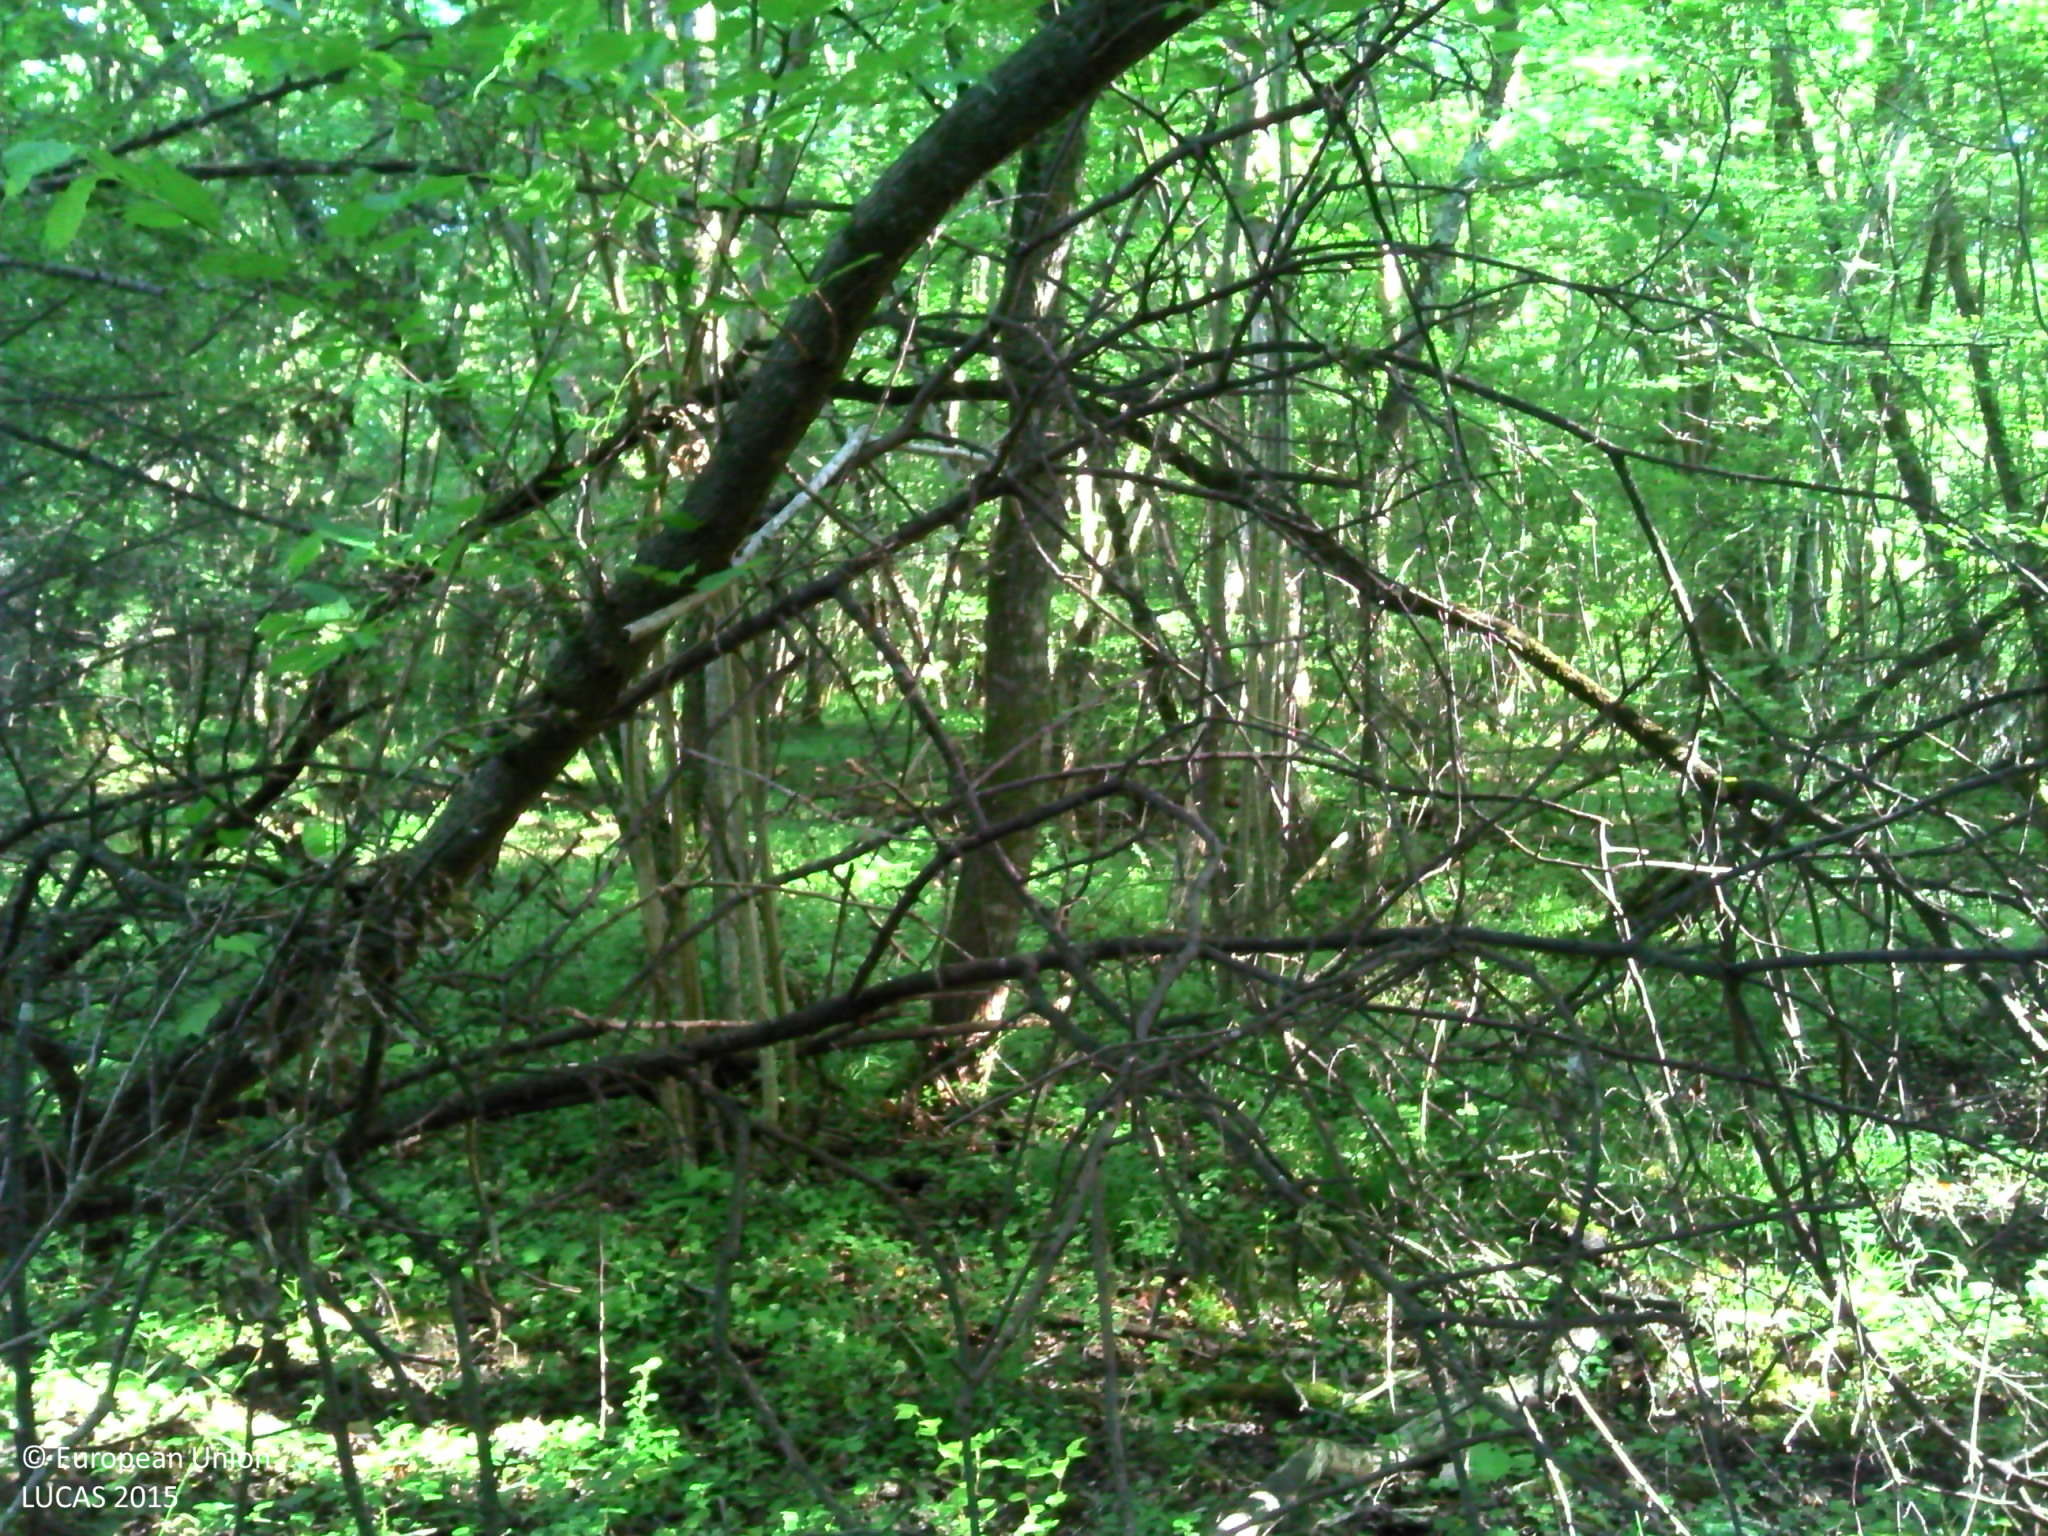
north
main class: Woodland
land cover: Broadleaved woodland
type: beech forest
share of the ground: > 75 %
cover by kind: broadleaved forest trees 90 %, herbaceous plants 10 %
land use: Forestry
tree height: > 5 m
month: June
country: FR
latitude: 46.9851
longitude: 2.9352
